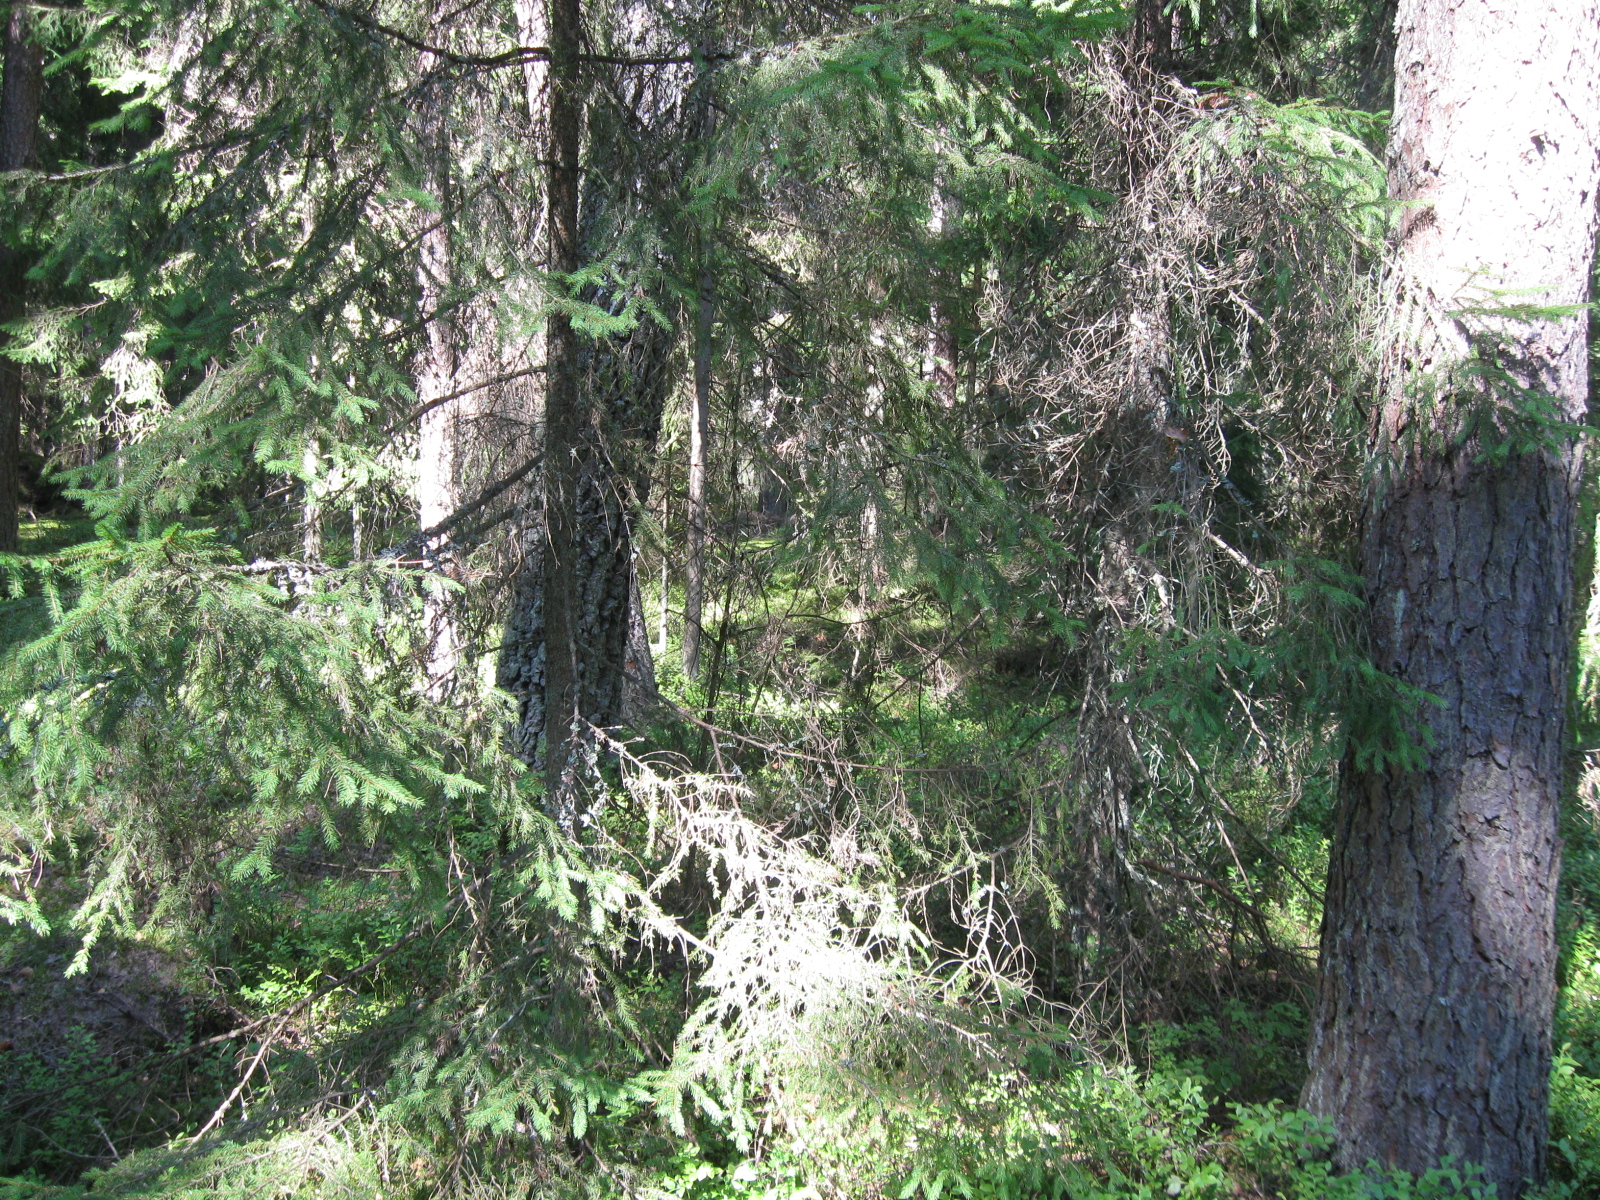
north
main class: Woodland
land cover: Other coniferous woodland
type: hemiboreal forest and nemoral coniferous forest and mixed broadleaved-coniferous forest
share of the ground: > 75 %
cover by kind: coniferous forest trees 85 %, lichens and mosses 10 %, shrubs 5 %
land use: Forestry
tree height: > 5 m
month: August
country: LT
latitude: 54.9416
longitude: 23.4898
